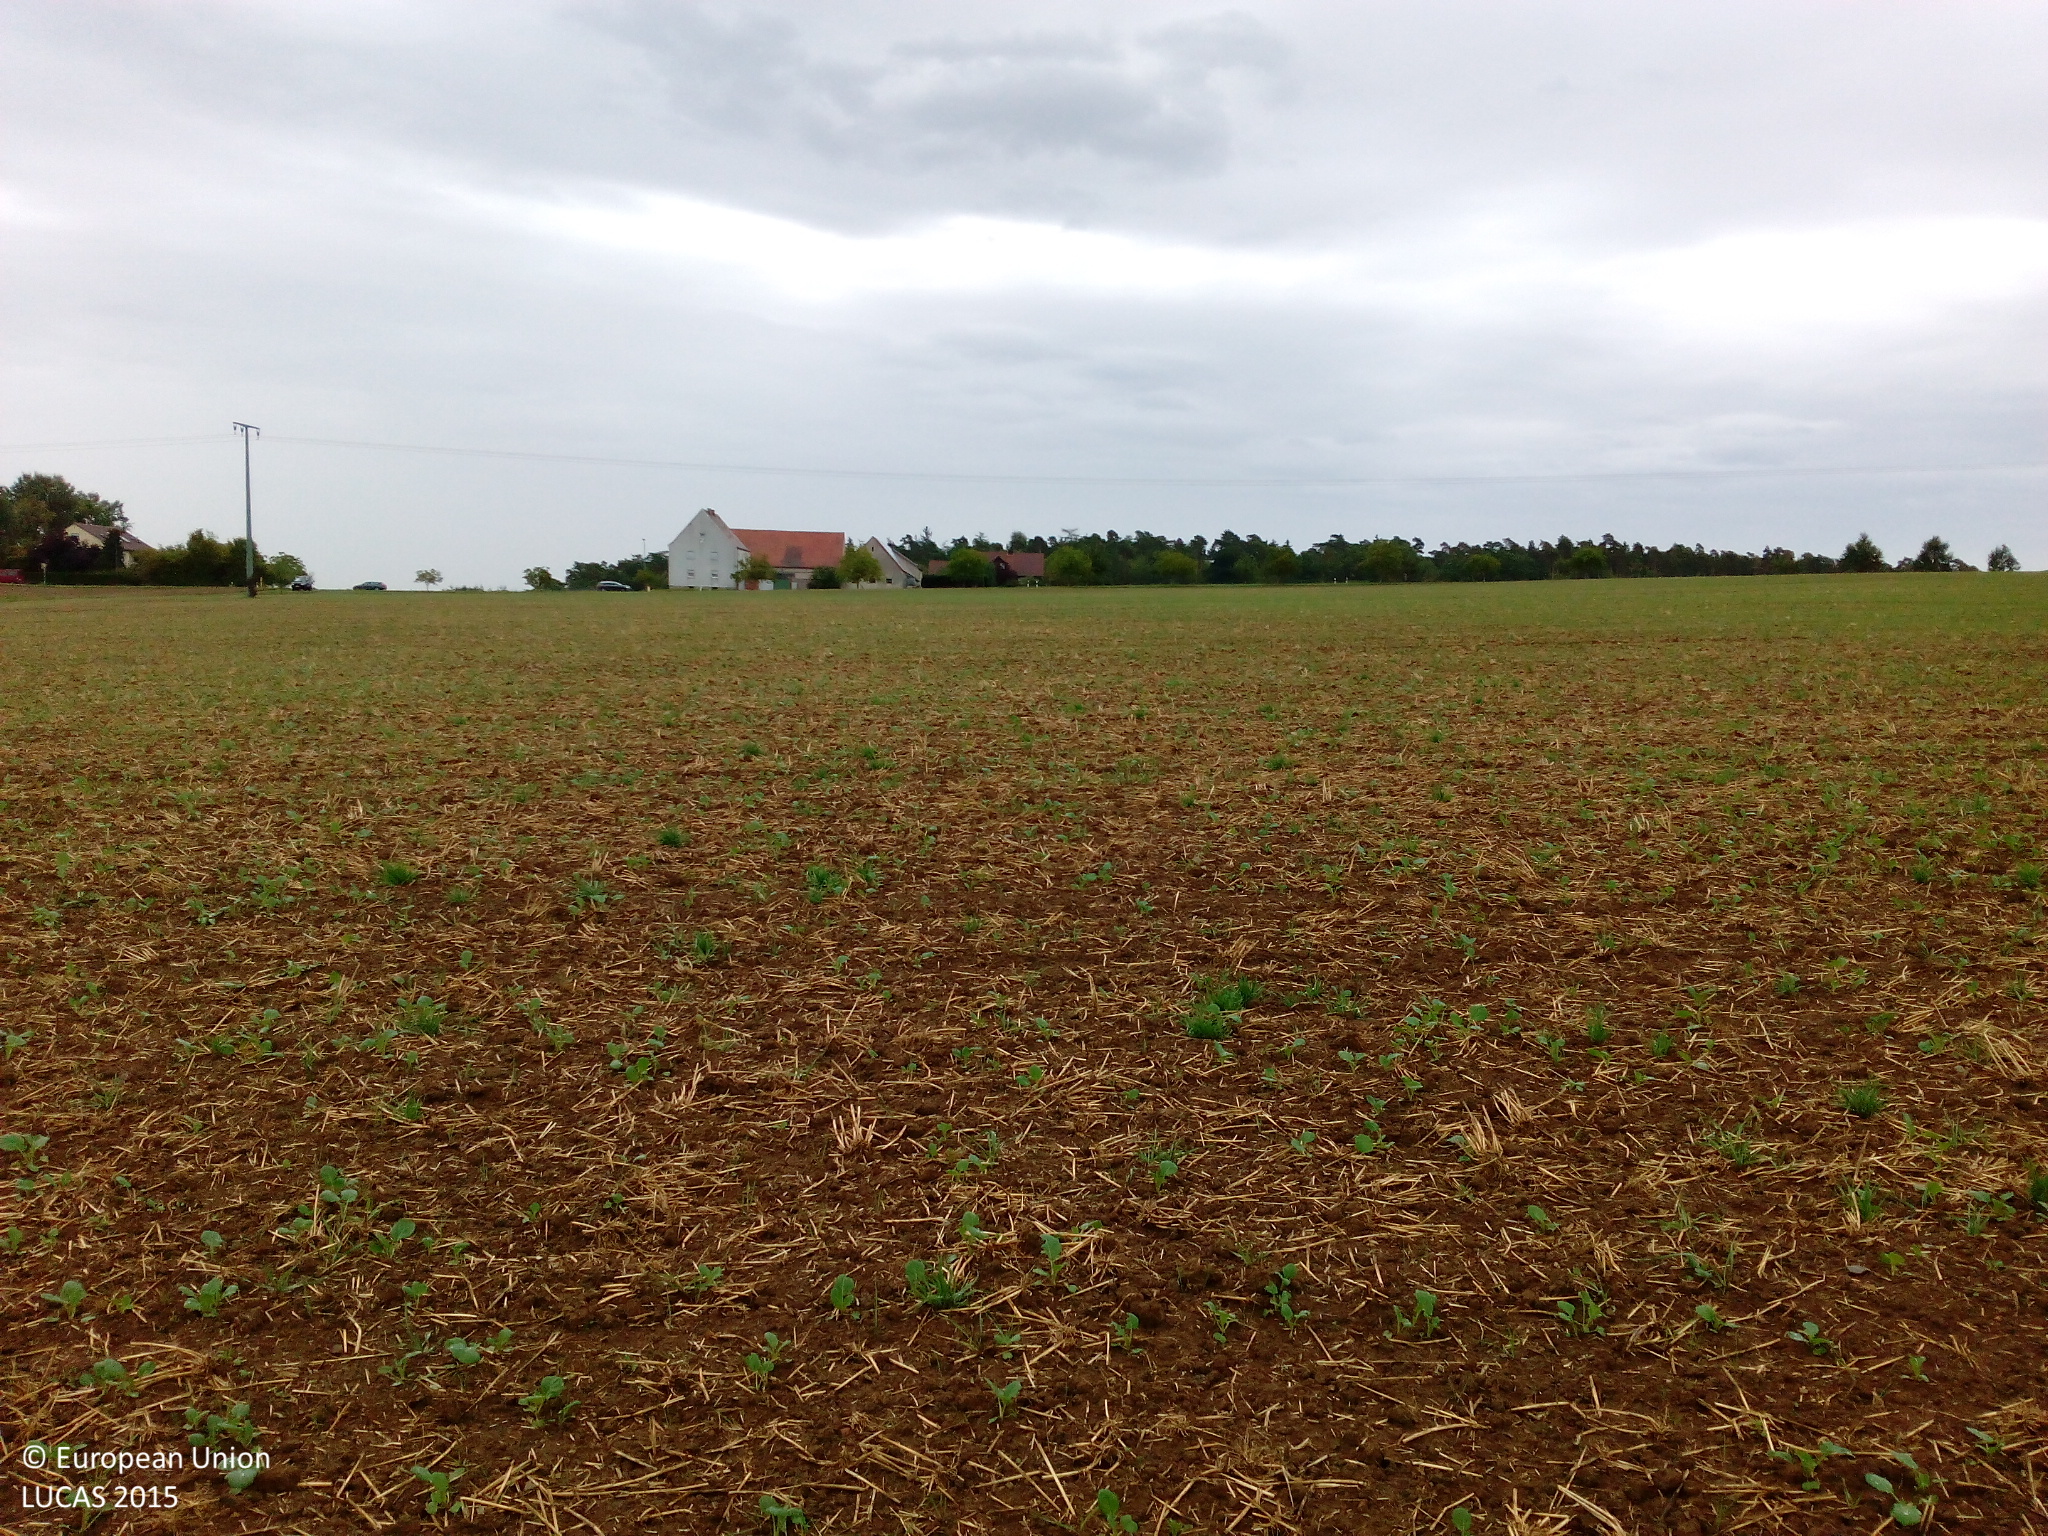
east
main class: Cropland
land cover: Common wheat
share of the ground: 10 - 25 %
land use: Agriculture (excluding fallow land and kitchen gardens)
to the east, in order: Common wheat; Electric lines; Common wheat; Grass margins; Lines of trees; Ditches and canals; Grass margins; Paved roads, cycling and walking lanes; Grass margins; Ditches and canals; Grass margins
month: September
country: DE
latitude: 49.8425
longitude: 9.9027
